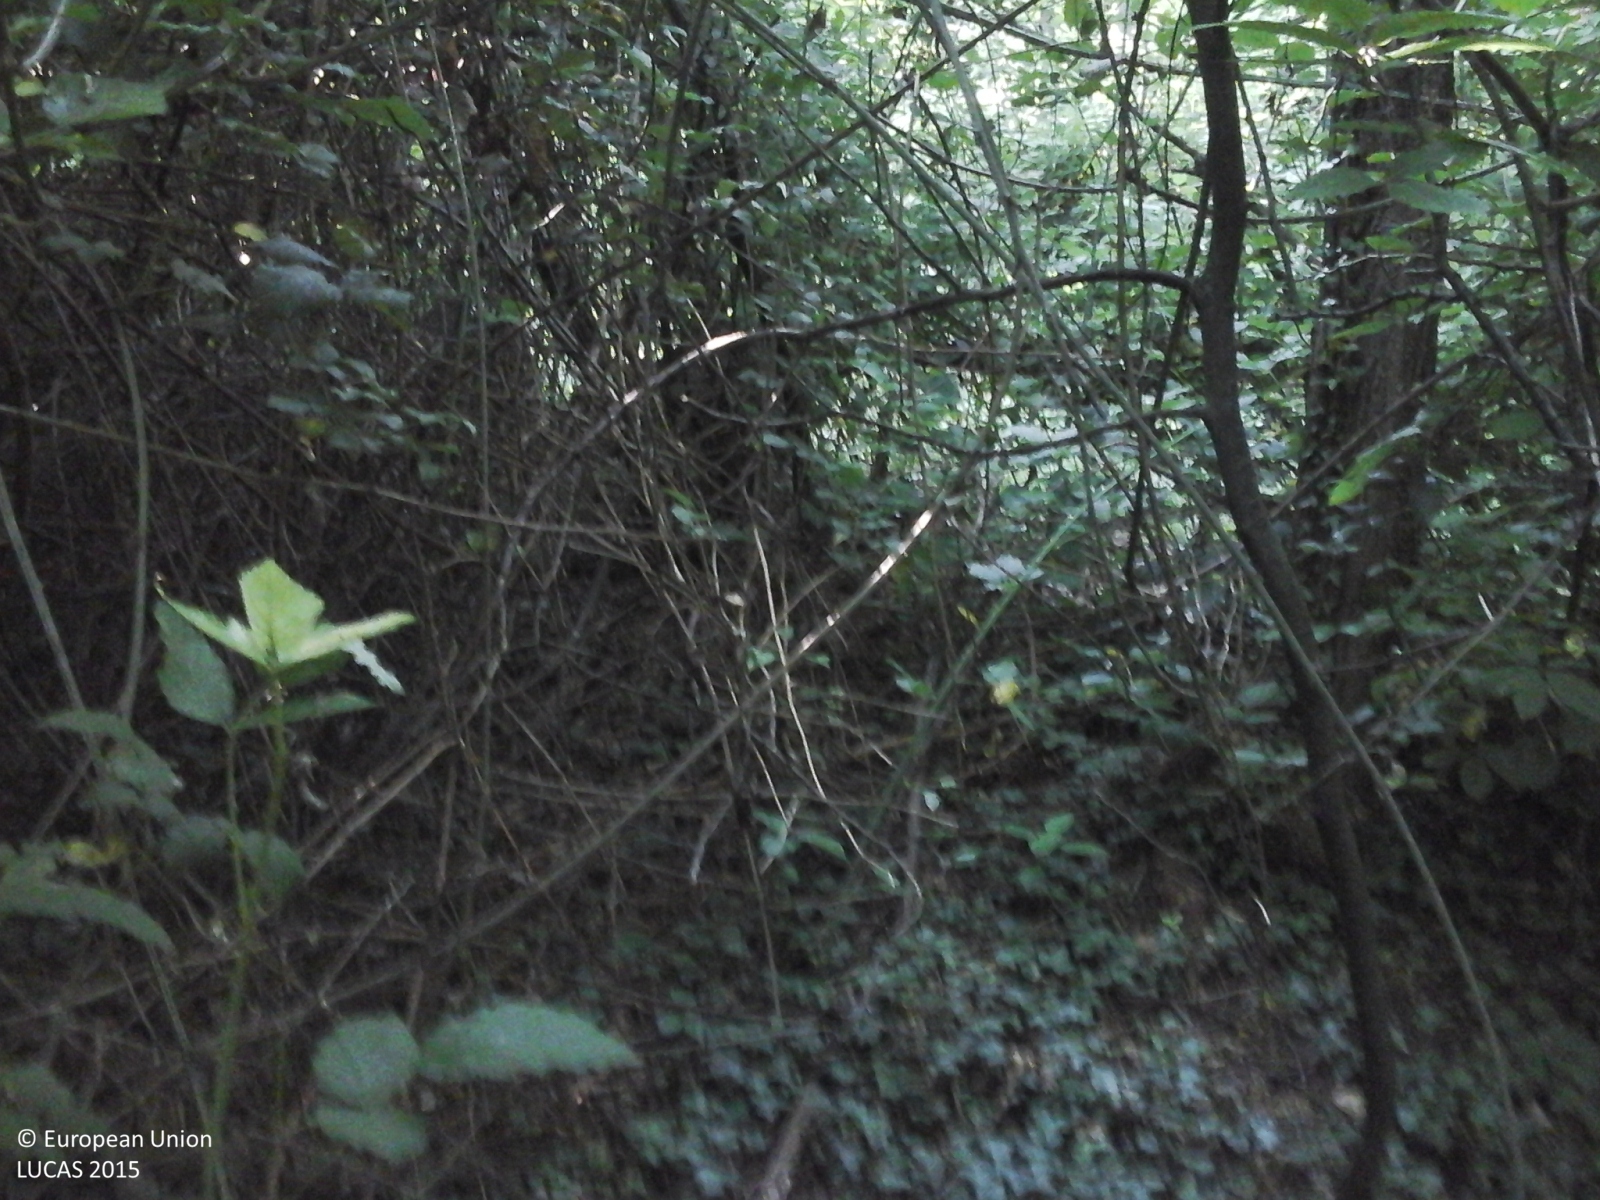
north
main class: Woodland
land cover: Broadleaved woodland
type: thermophilous deciduous forest
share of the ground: > 75 %
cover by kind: broadleaved forest trees 100 %
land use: Forestry
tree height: > 5 m
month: June
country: IT
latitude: 45.4498
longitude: 8.0213
